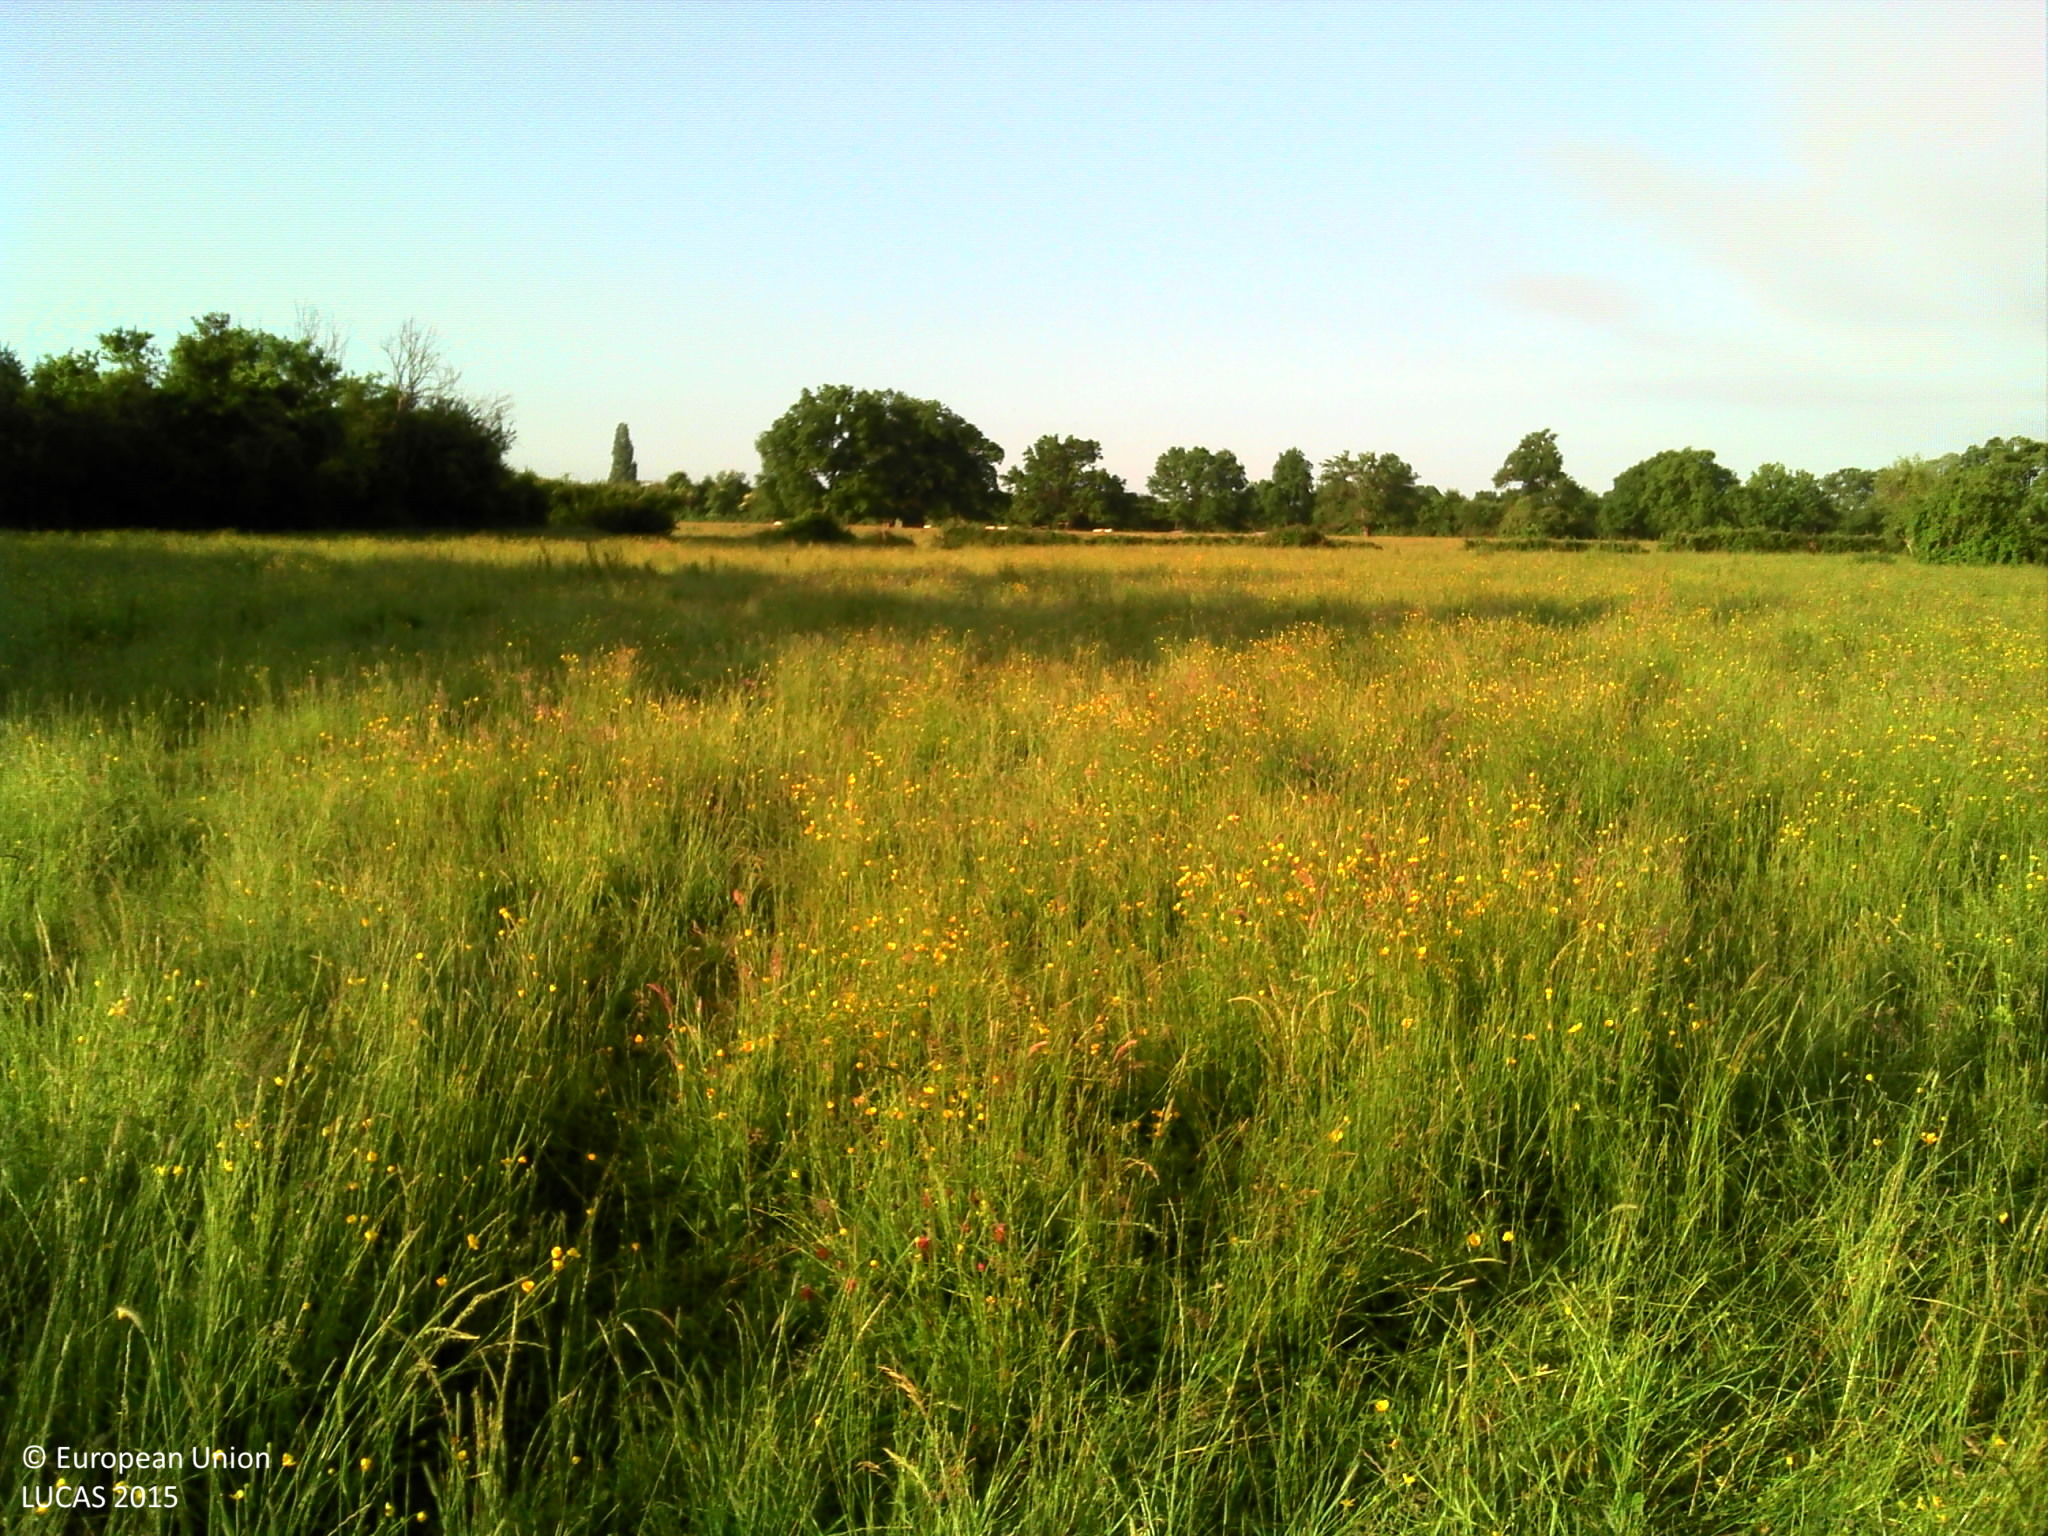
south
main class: Grassland
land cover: Grassland without tree/shrub cover
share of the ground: > 75 %
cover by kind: herbaceous plants 100 %
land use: Agriculture (excluding fallow land and kitchen gardens)
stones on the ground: < 10 %
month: June
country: FR
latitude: 46.9747
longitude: 2.7782
